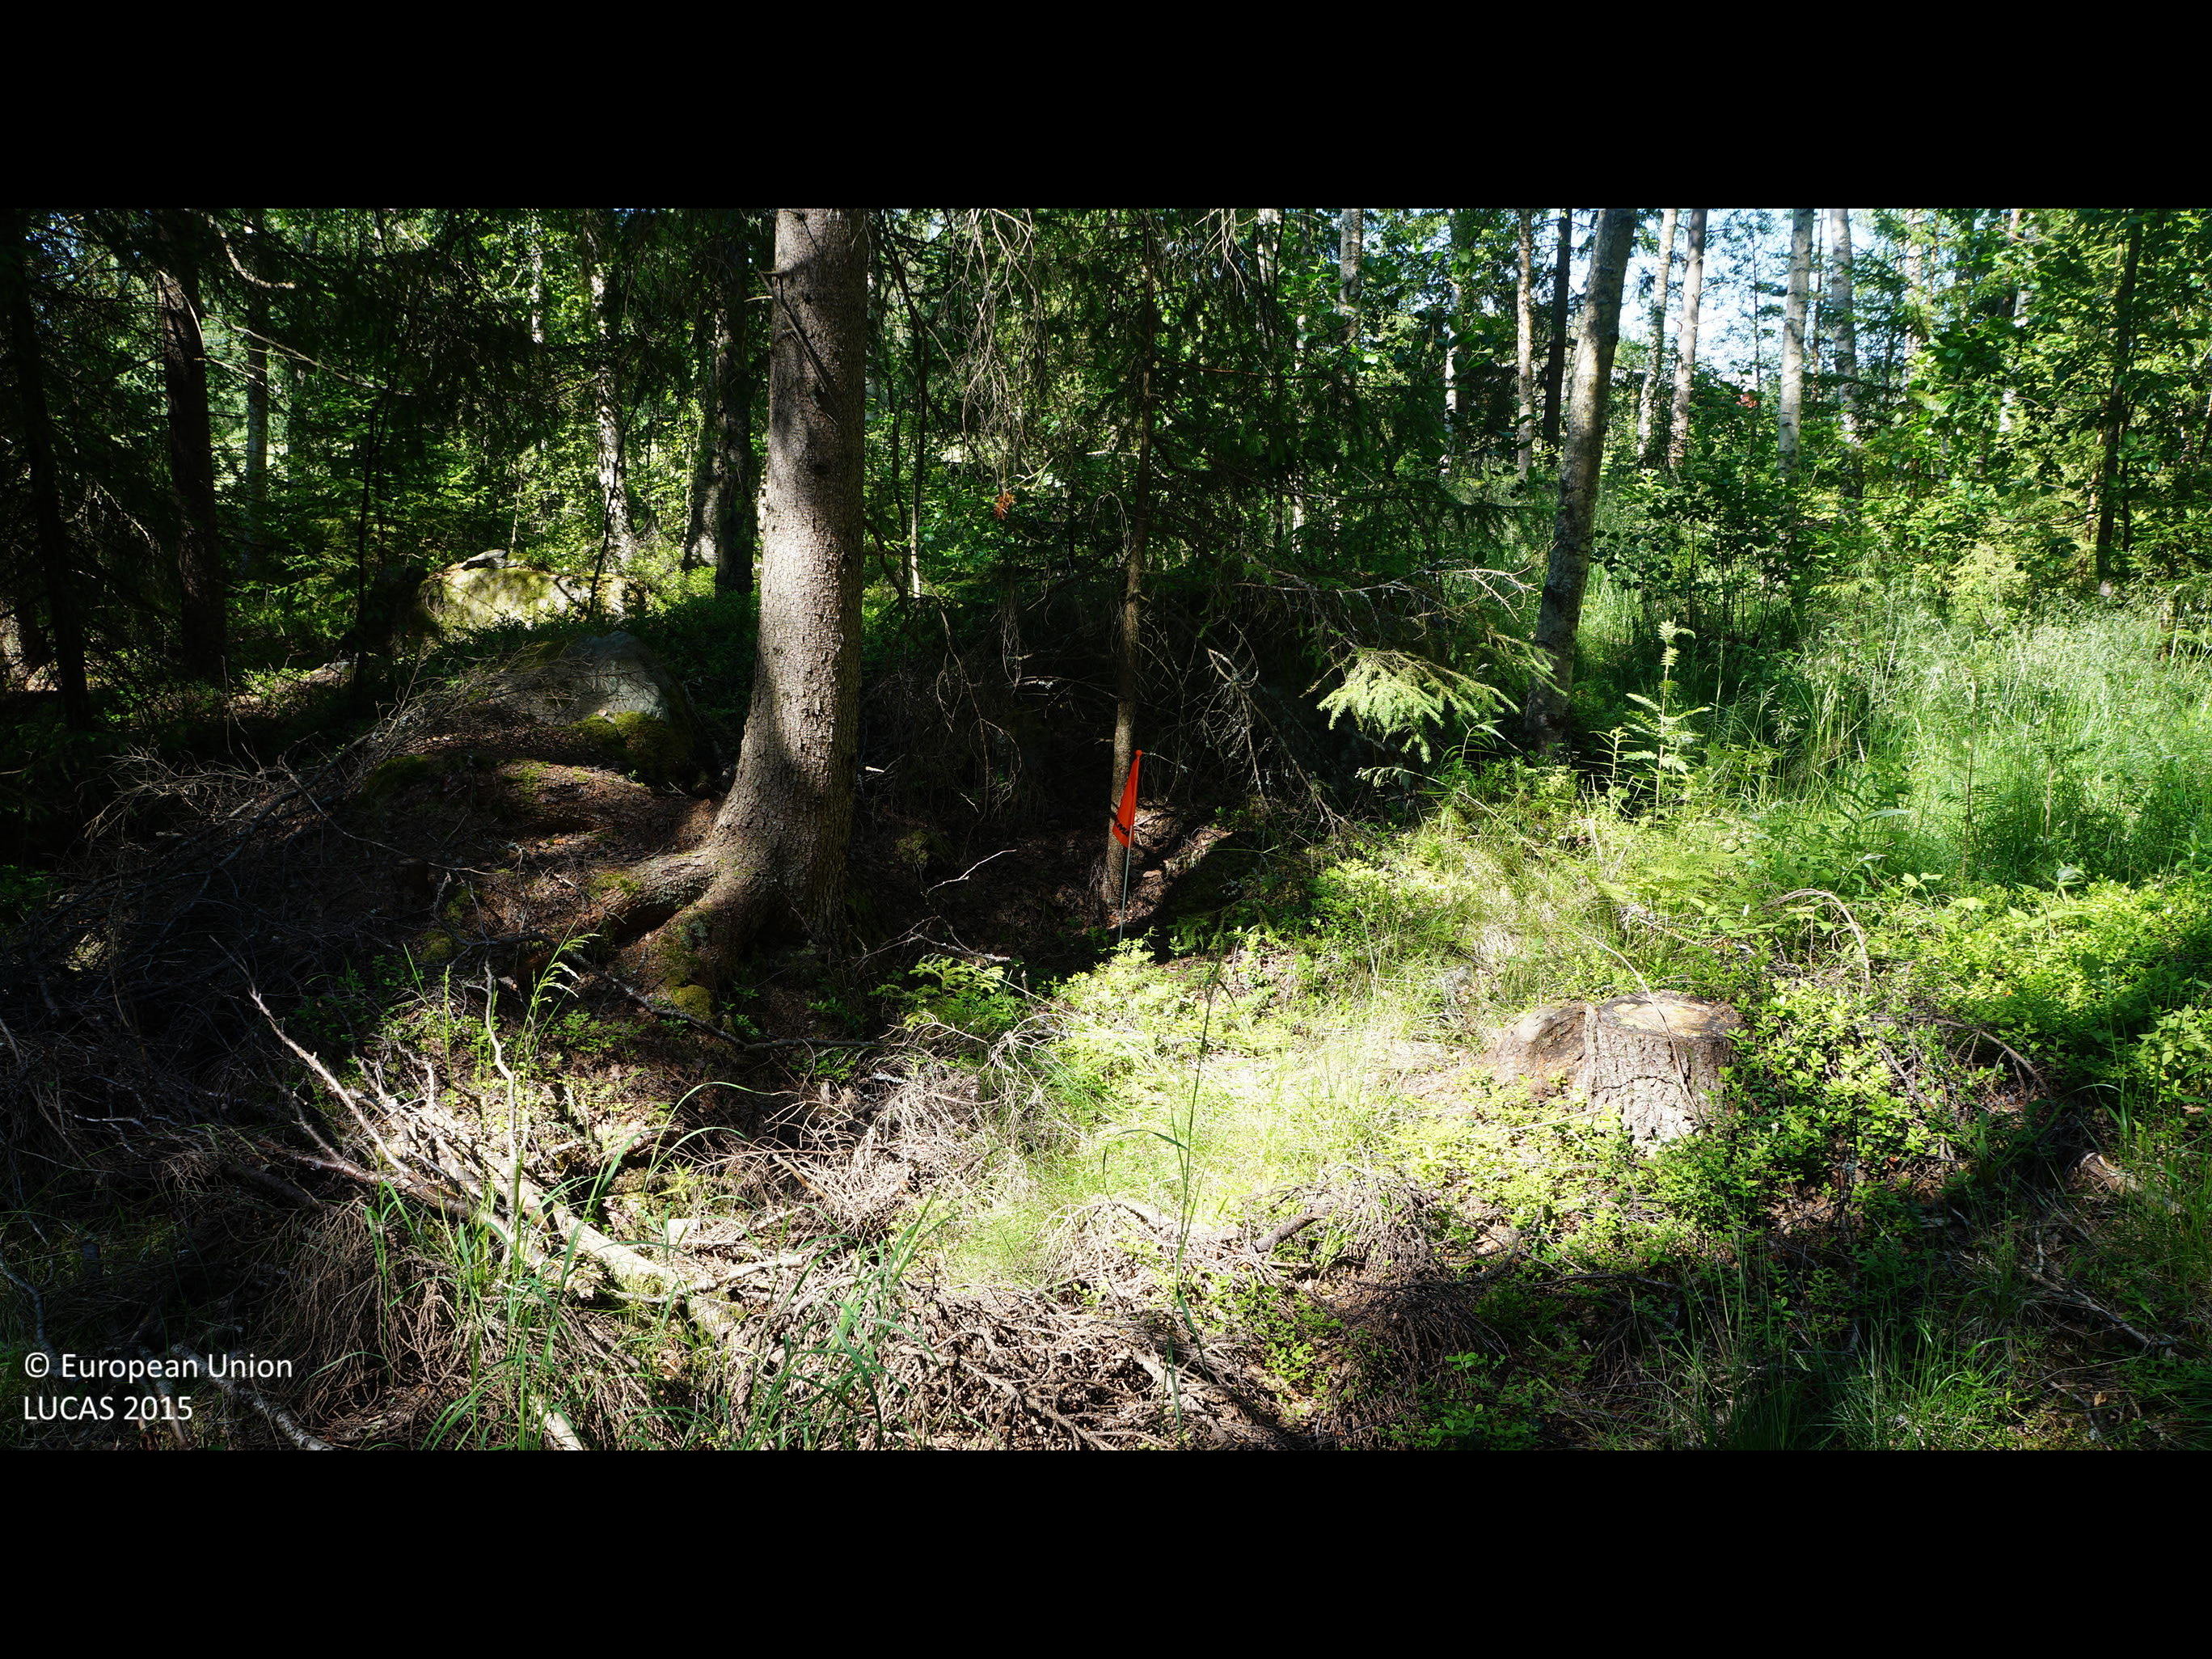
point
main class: Woodland
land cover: Spruce dominated mixed woodland
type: boreal forest
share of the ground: 50 - 75 %
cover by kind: coniferous forest trees 40 %, shrubs 25 %, broadleaved forest trees 20 %, herbaceous plants 15 %
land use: Forestry
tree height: > 5 m
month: July
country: FI
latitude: 63.7959
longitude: 22.8986
